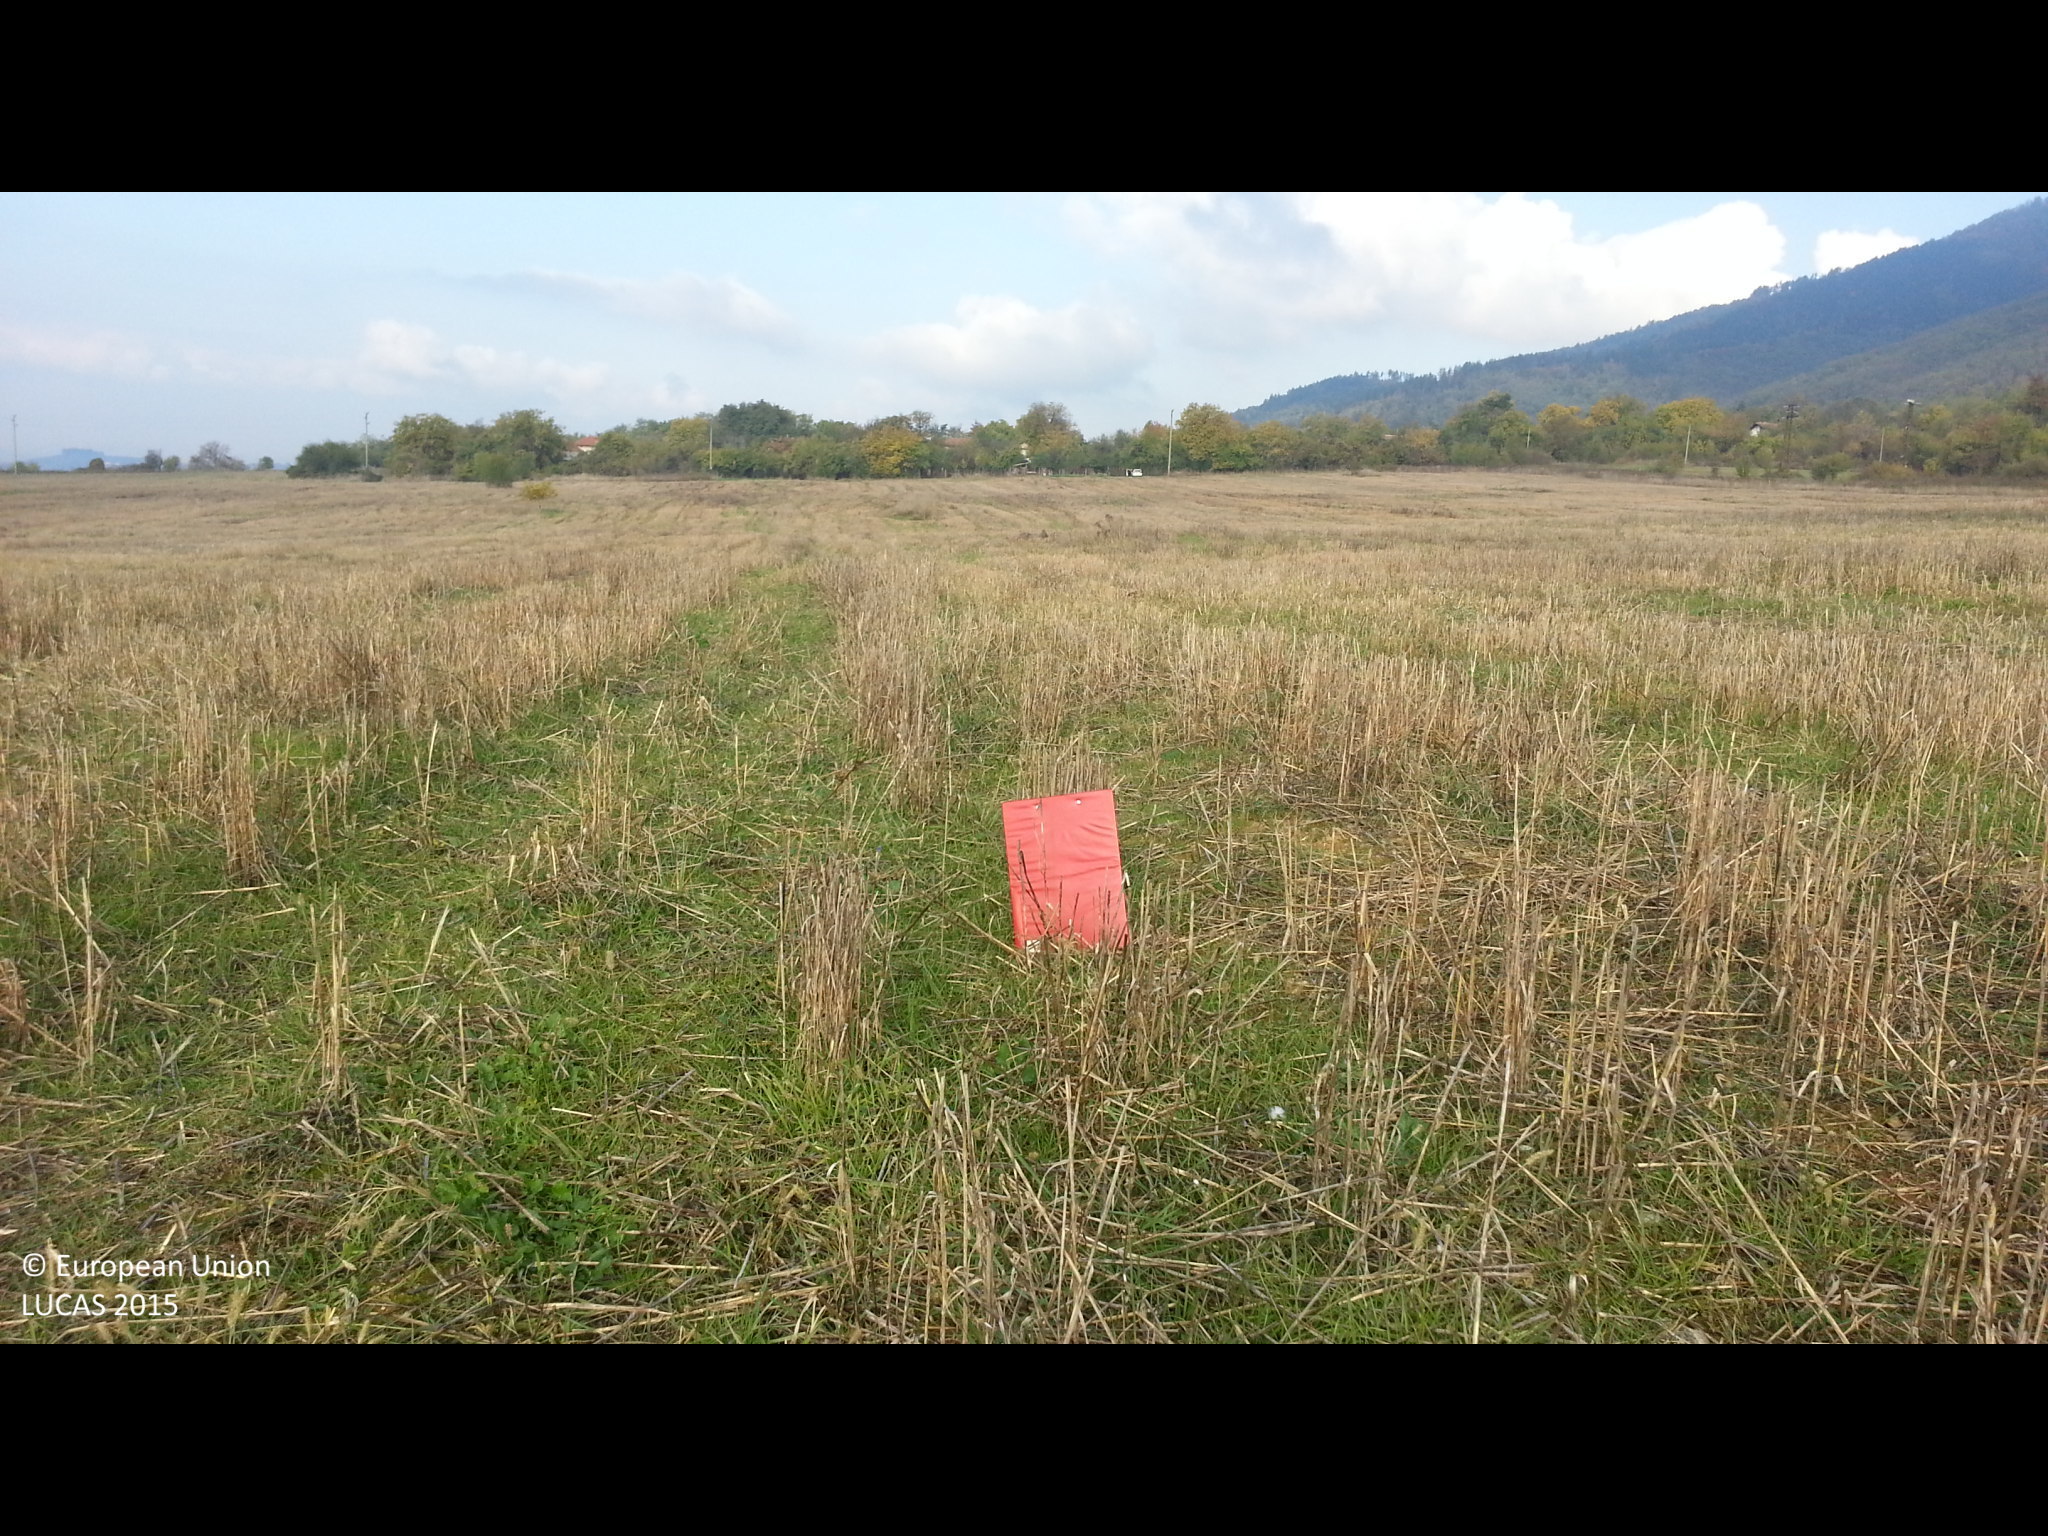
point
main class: Cropland
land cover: Common wheat
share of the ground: 10 - 25 %
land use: Agriculture (excluding fallow land and kitchen gardens)
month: November
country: BG
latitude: 42.9194
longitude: 23.8760
